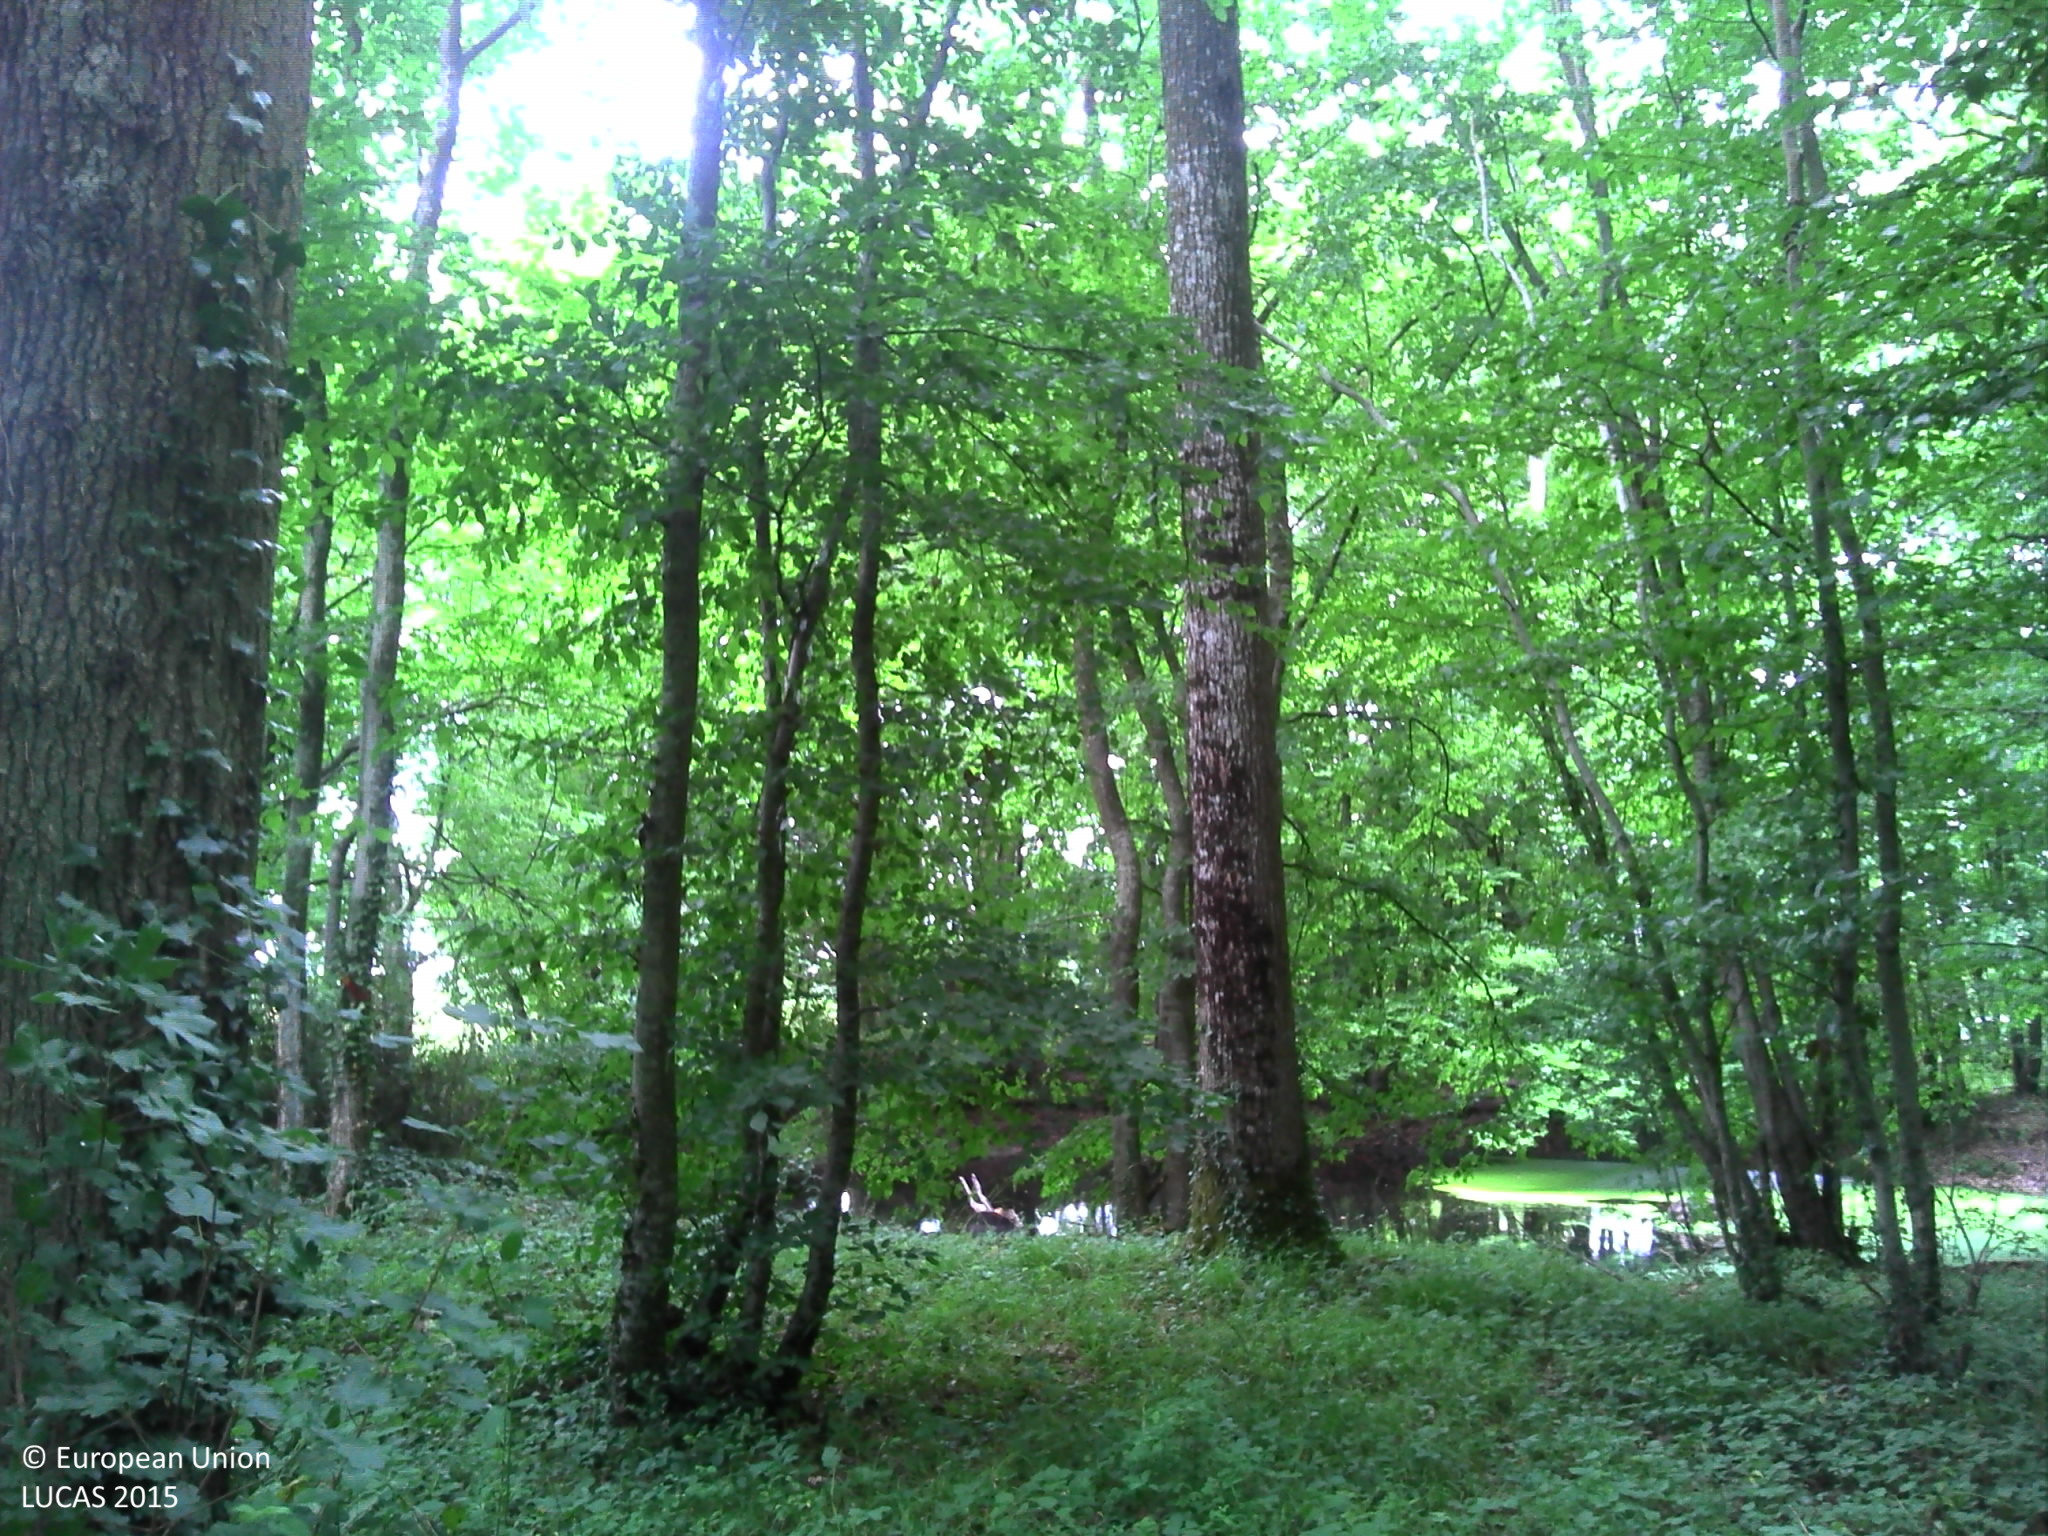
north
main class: Woodland
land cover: Broadleaved woodland
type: beech forest
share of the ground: > 75 %
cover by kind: broadleaved forest trees 65 %, herbaceous plants 20 %, shrubs 15 %
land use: Forestry
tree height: > 5 m
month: June
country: FR
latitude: 48.1177
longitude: 0.2620
